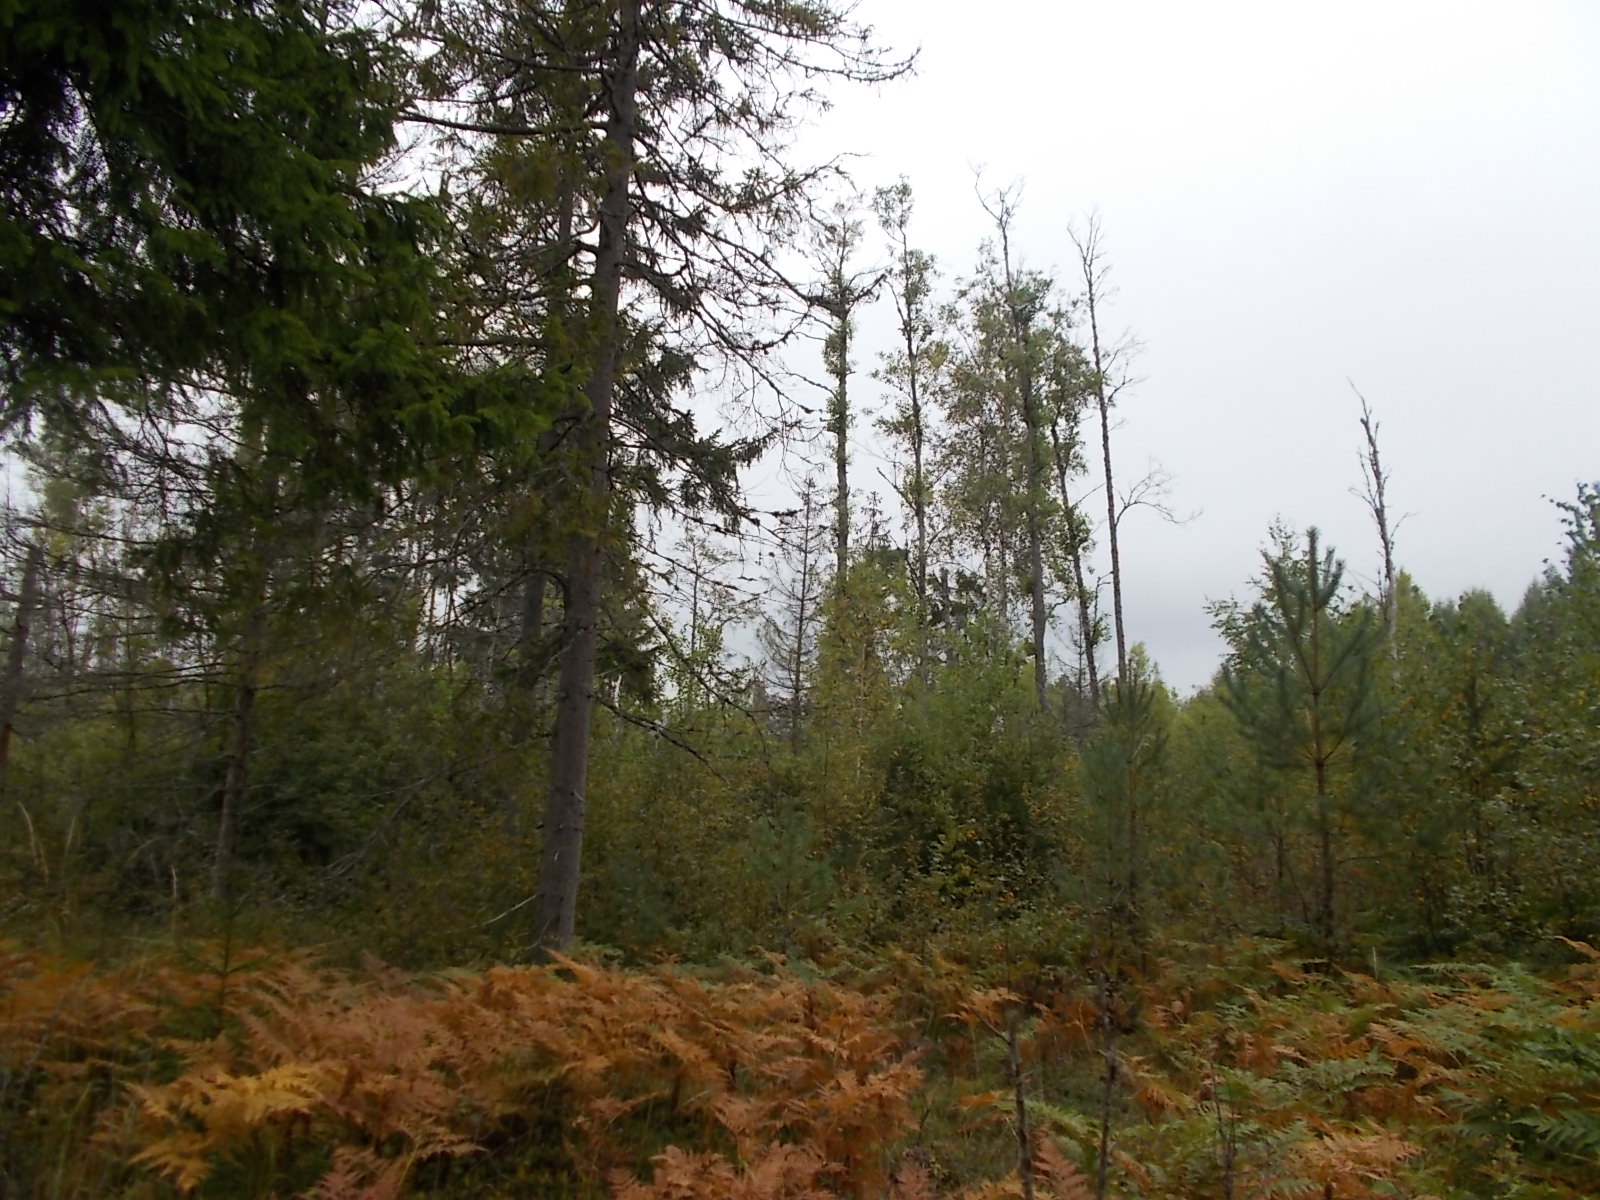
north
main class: Woodland
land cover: Other mixed woodland
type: hemiboreal forest and nemoral coniferous forest and mixed broadleaved-coniferous forest
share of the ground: 50 - 75 %
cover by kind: coniferous forest trees 30 %, broadleaved forest trees 30 %, herbaceous plants 30 %, shrubs 10 %
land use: Forestry
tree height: > 5 m
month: September
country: LV
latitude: 57.1602
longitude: 22.1013
